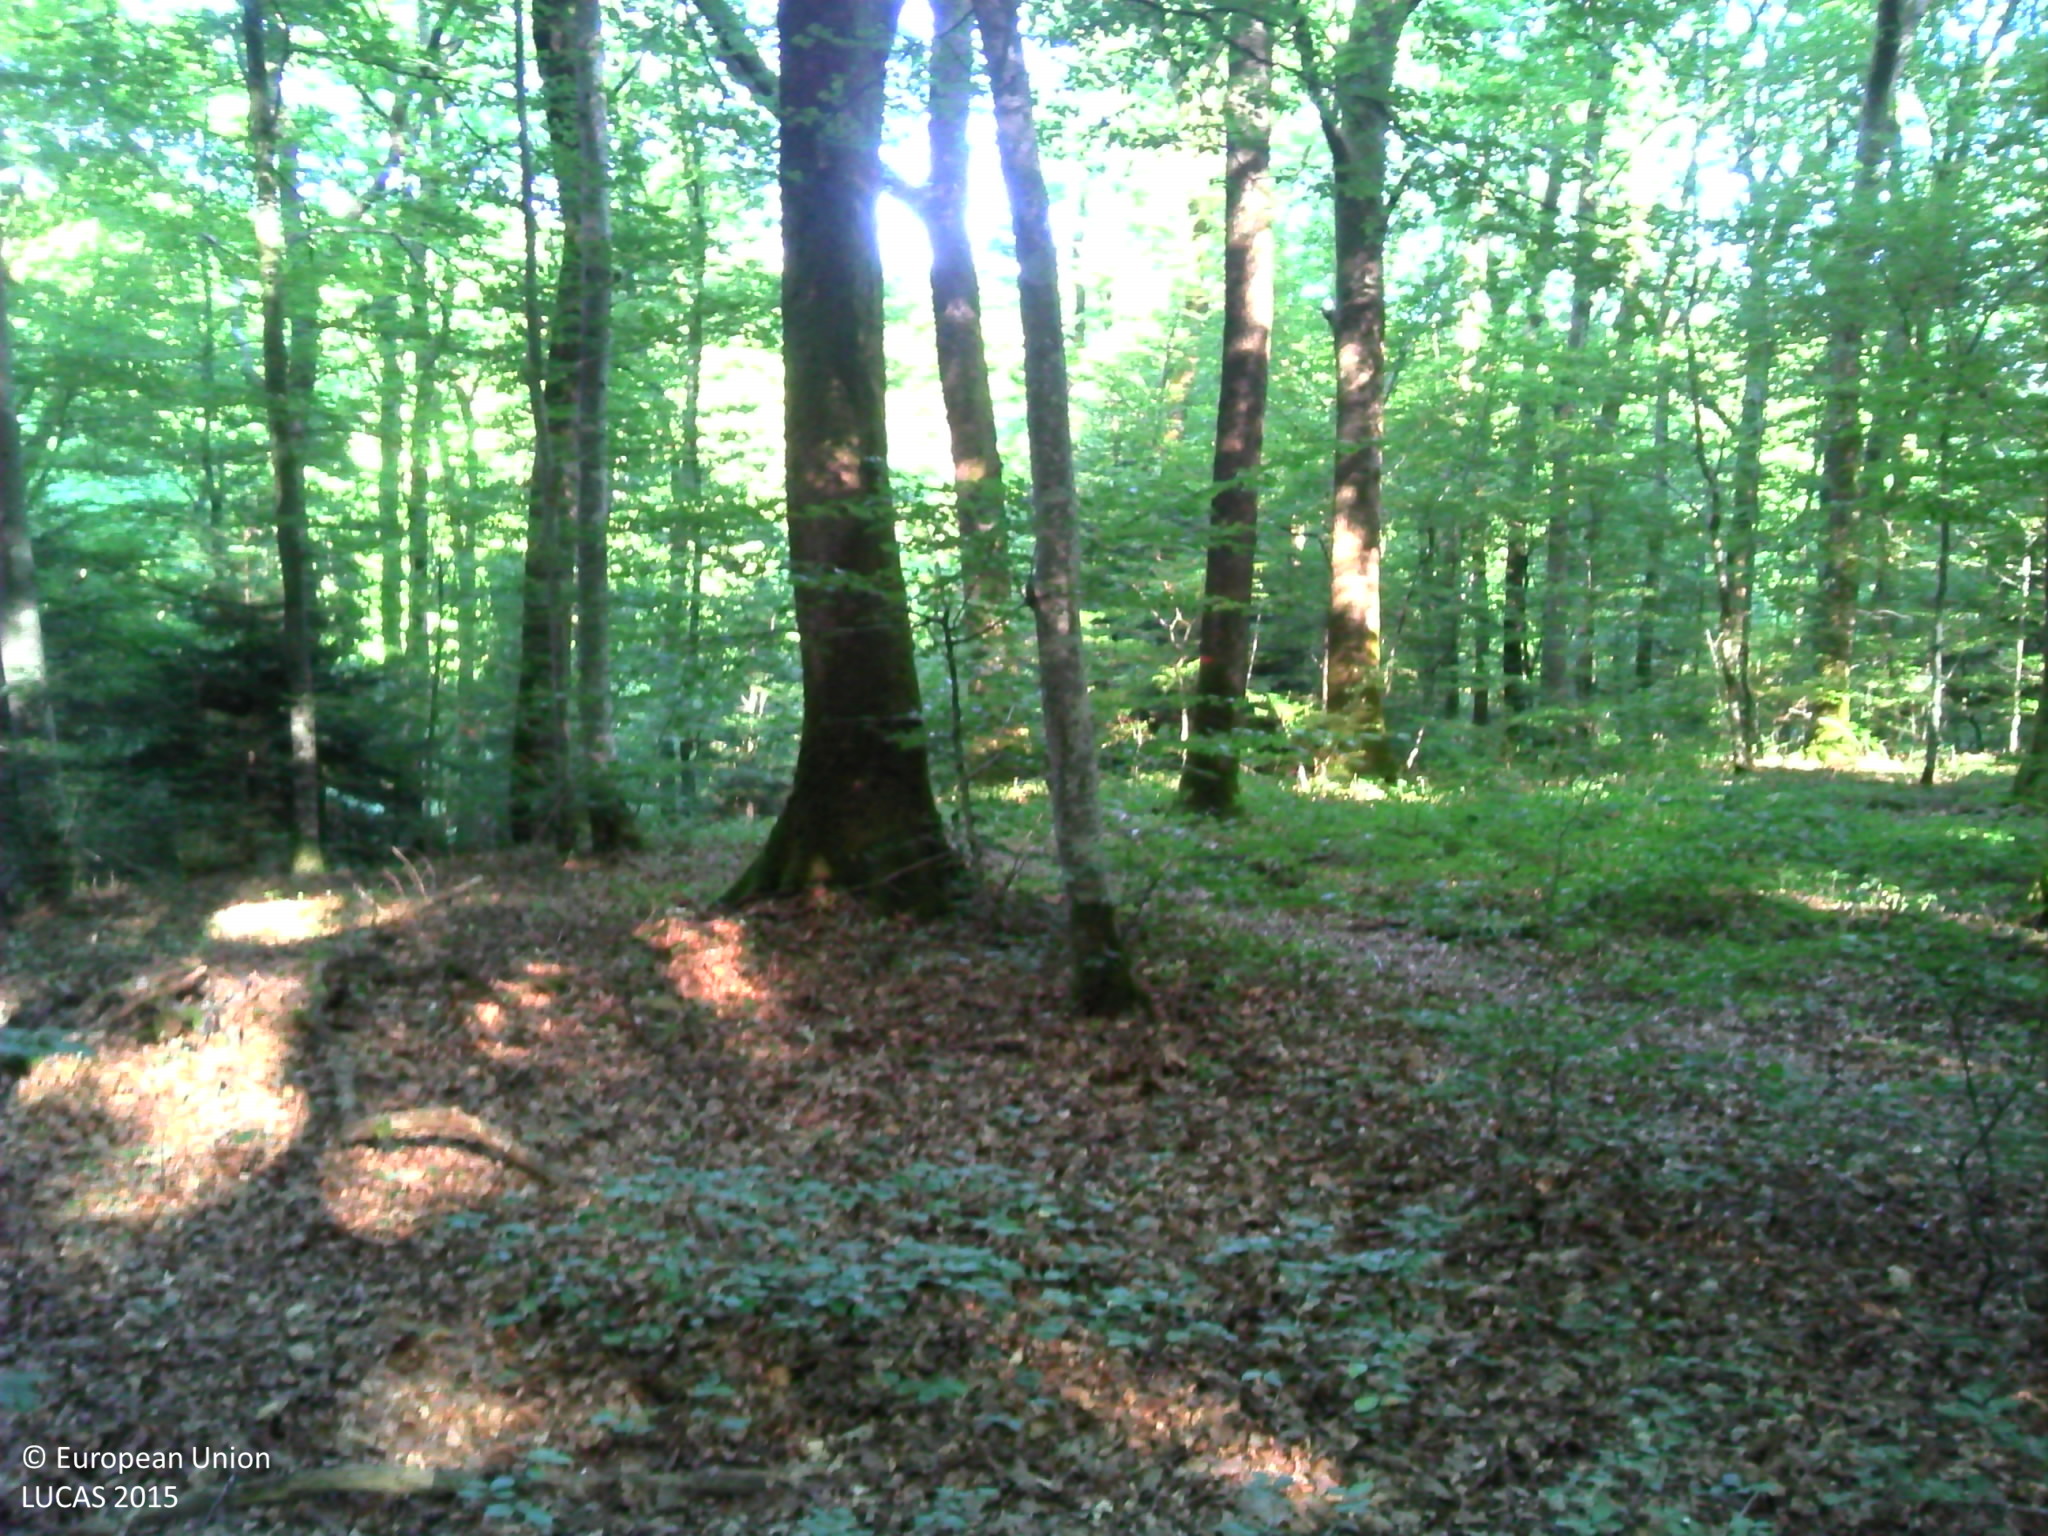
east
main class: Woodland
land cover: Broadleaved woodland
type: beech forest
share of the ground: > 75 %
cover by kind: broadleaved forest trees 90 %, coniferous forest trees 10 %
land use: Forestry
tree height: > 5 m
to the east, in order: Broadleaved woodland; Dry stone walls; Broadleaved woodland; Shrubland with sparse tree cover; Tracks; Shrubland with sparse tree cover; Broadleaved woodland; Grass margins; Paved roads, cycling and walking lanes; Grass margins; Broadleaved woodland
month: June
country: FR
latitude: 47.5224
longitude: 6.0569
